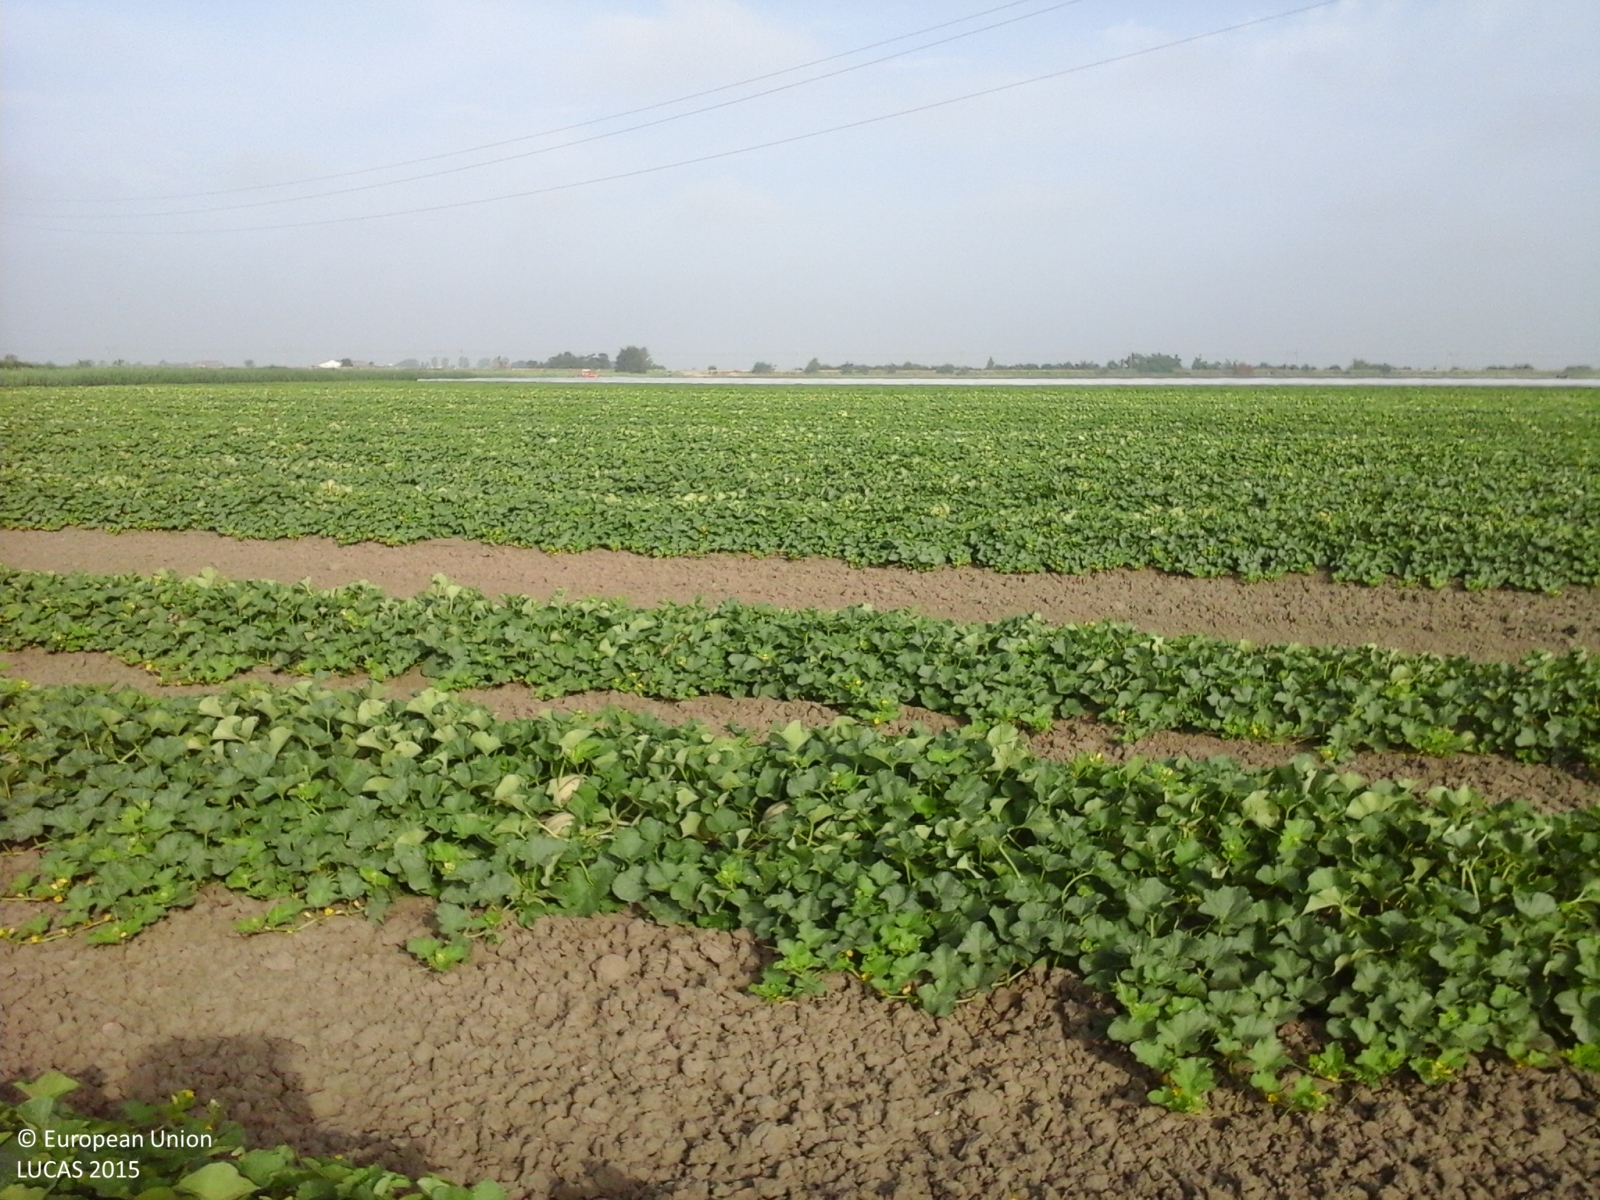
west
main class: Cropland
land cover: Other fresh vegetables
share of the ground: 50 - 75 %
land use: Agriculture (excluding fallow land and kitchen gardens)
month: June
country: IT
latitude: 44.9396
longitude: 11.1257
